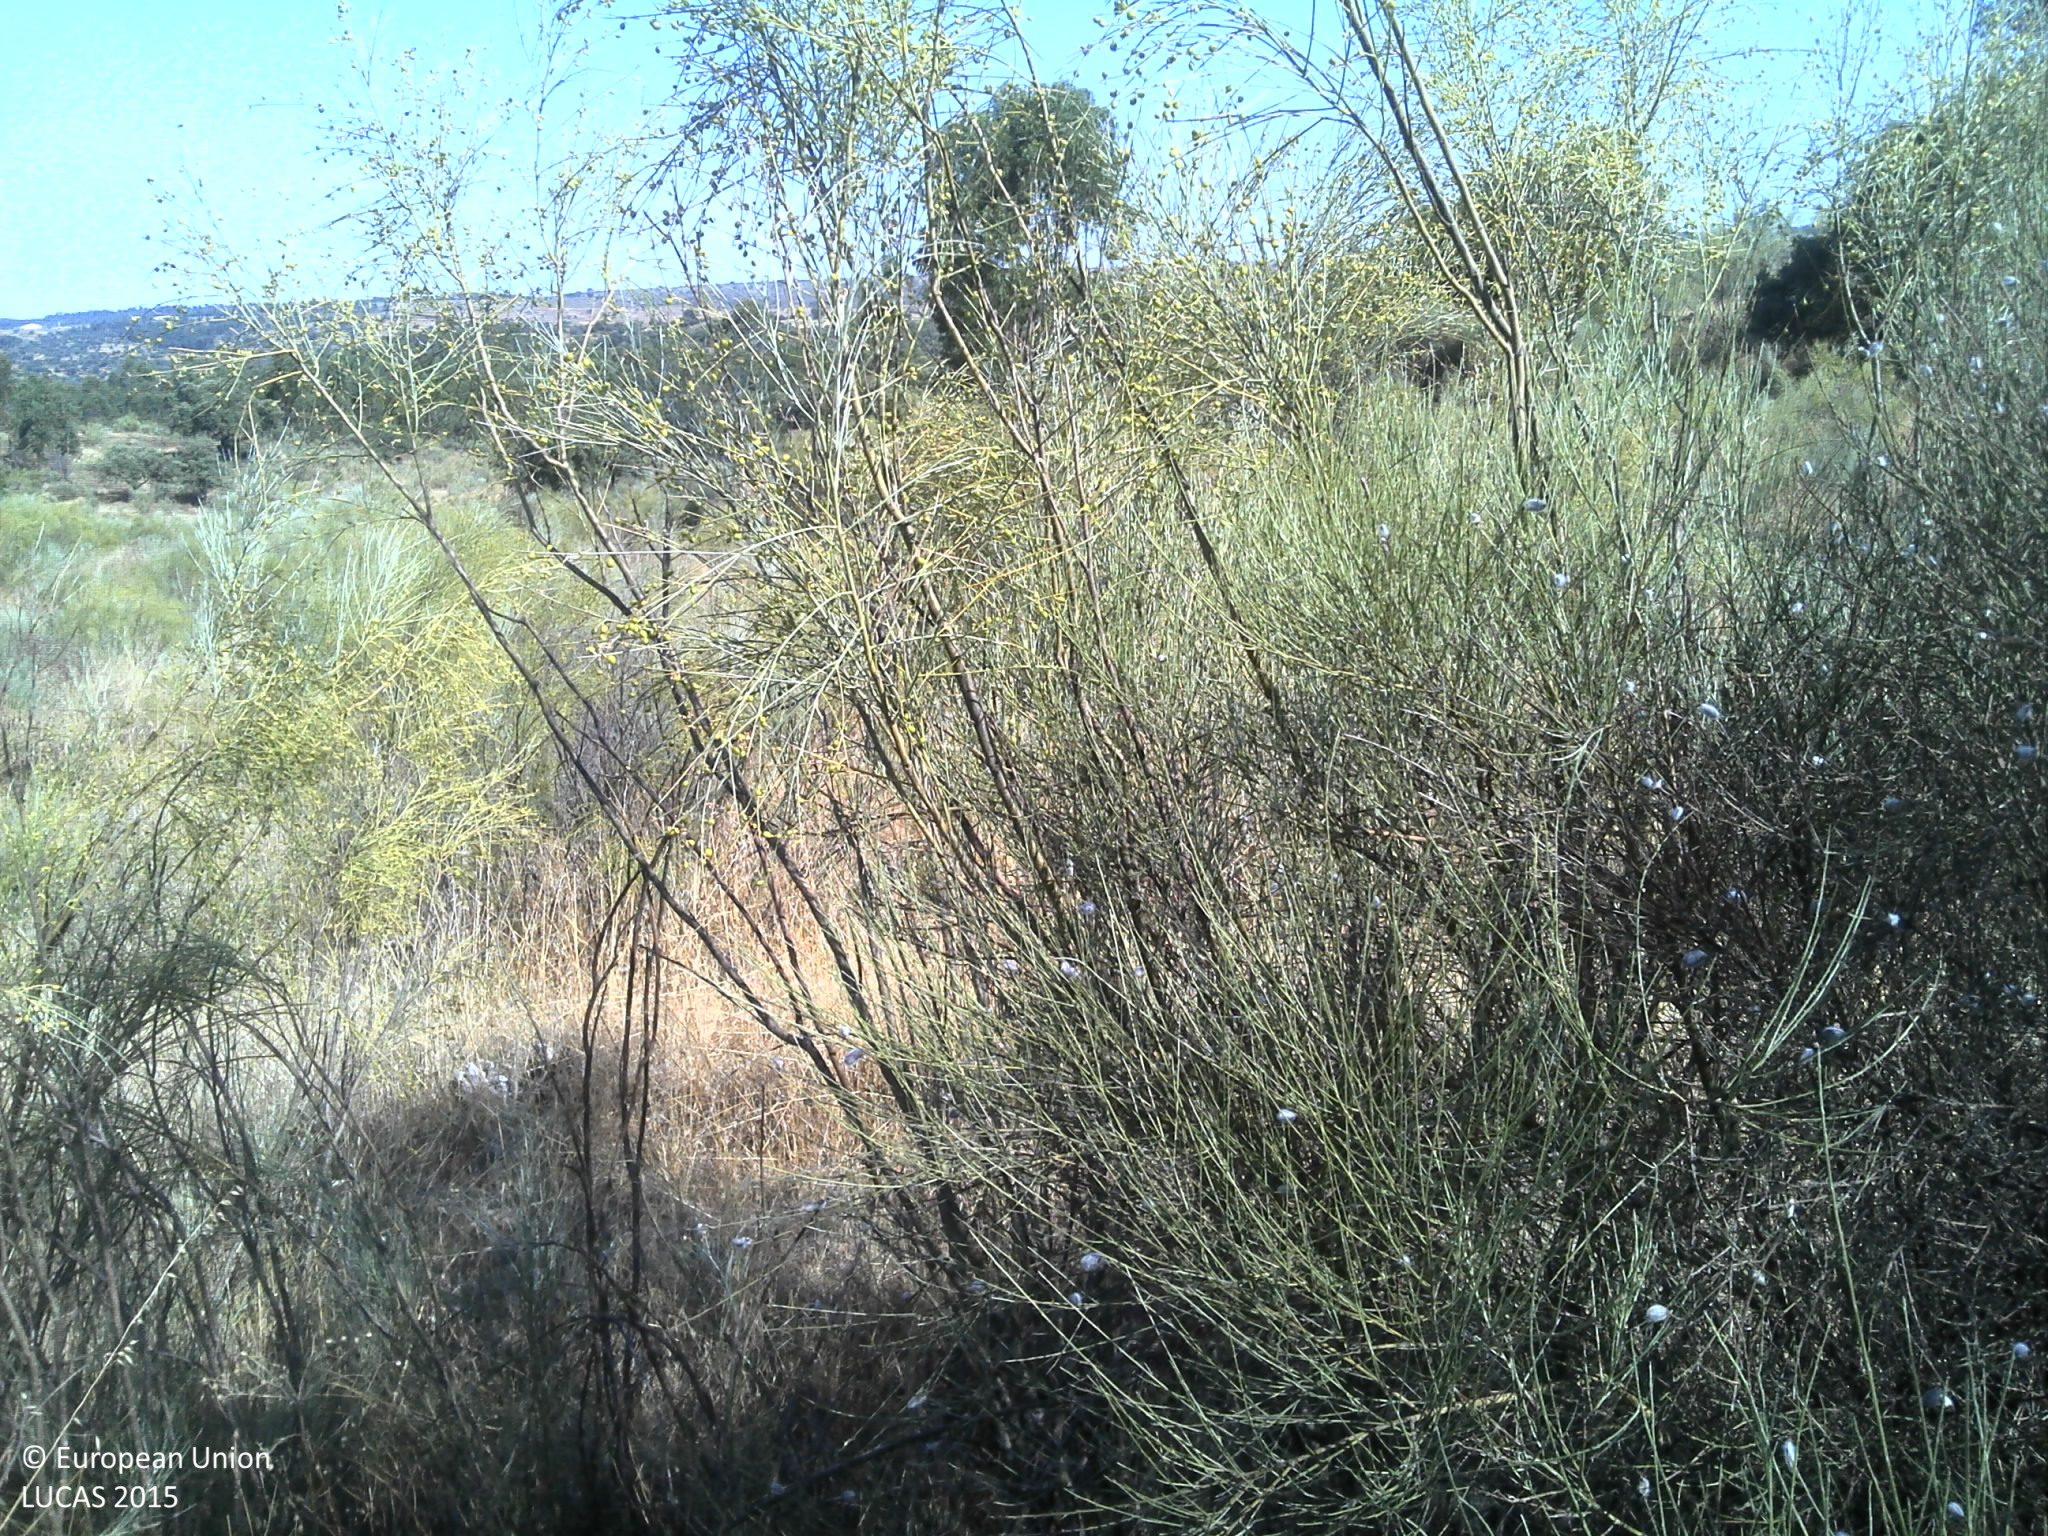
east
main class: Shrubland
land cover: Shrubland with sparse tree cover
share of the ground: 50 - 75 %
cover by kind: shrubs 50 %, herbaceous plants 25 %, unconsolidated bare surface 10 %, broadleaved forest trees 5 %
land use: Forestry
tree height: > 5 m
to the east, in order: Shrubland with sparse tree cover; Broadleaved woodland; Tracks; Shrubland with sparse tree cover; Tracks; Shrubland with sparse tree cover; Tracks; Shrubland with sparse tree cover
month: June
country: PT
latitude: 39.7940
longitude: -7.0567
